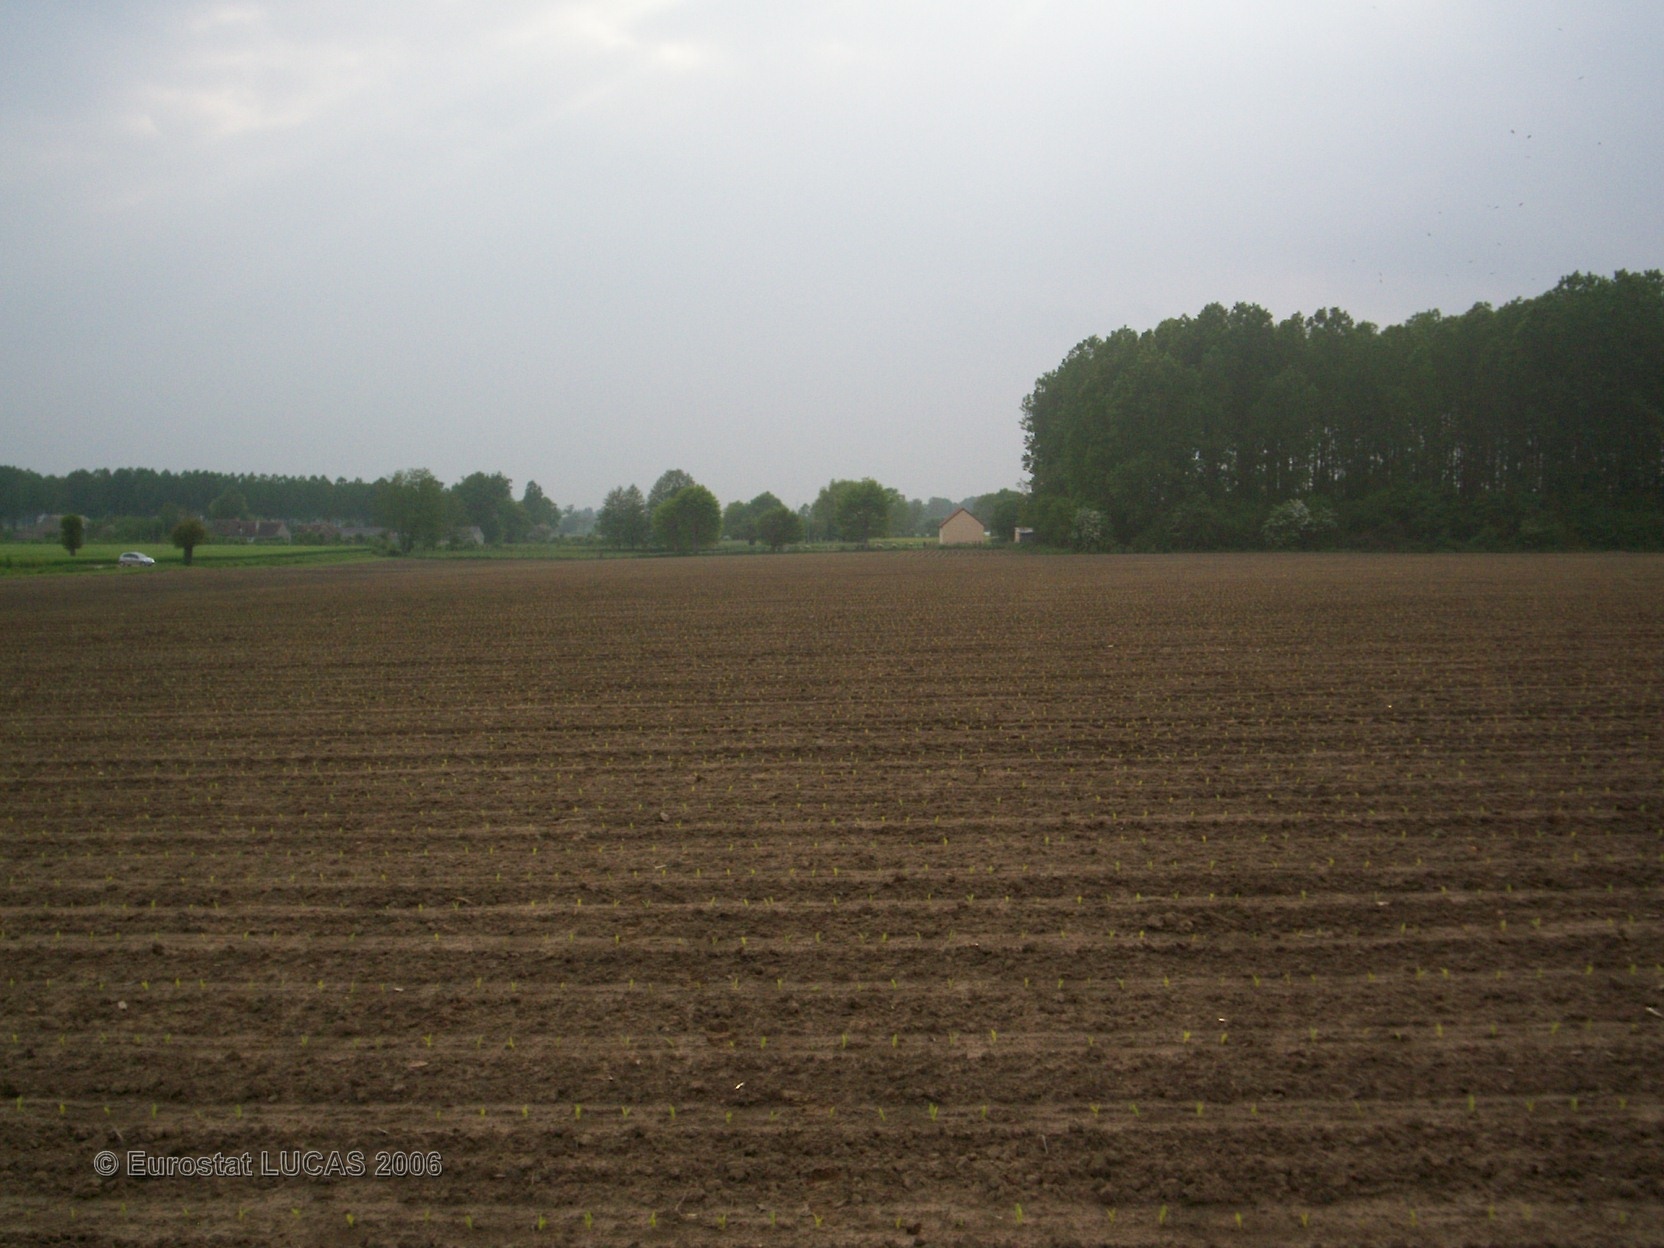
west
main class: Cropland
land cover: Maize
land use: Agriculture (excluding fallow land and kitchen gardens)
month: May
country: FR
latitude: 47.9039
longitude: 0.3031
